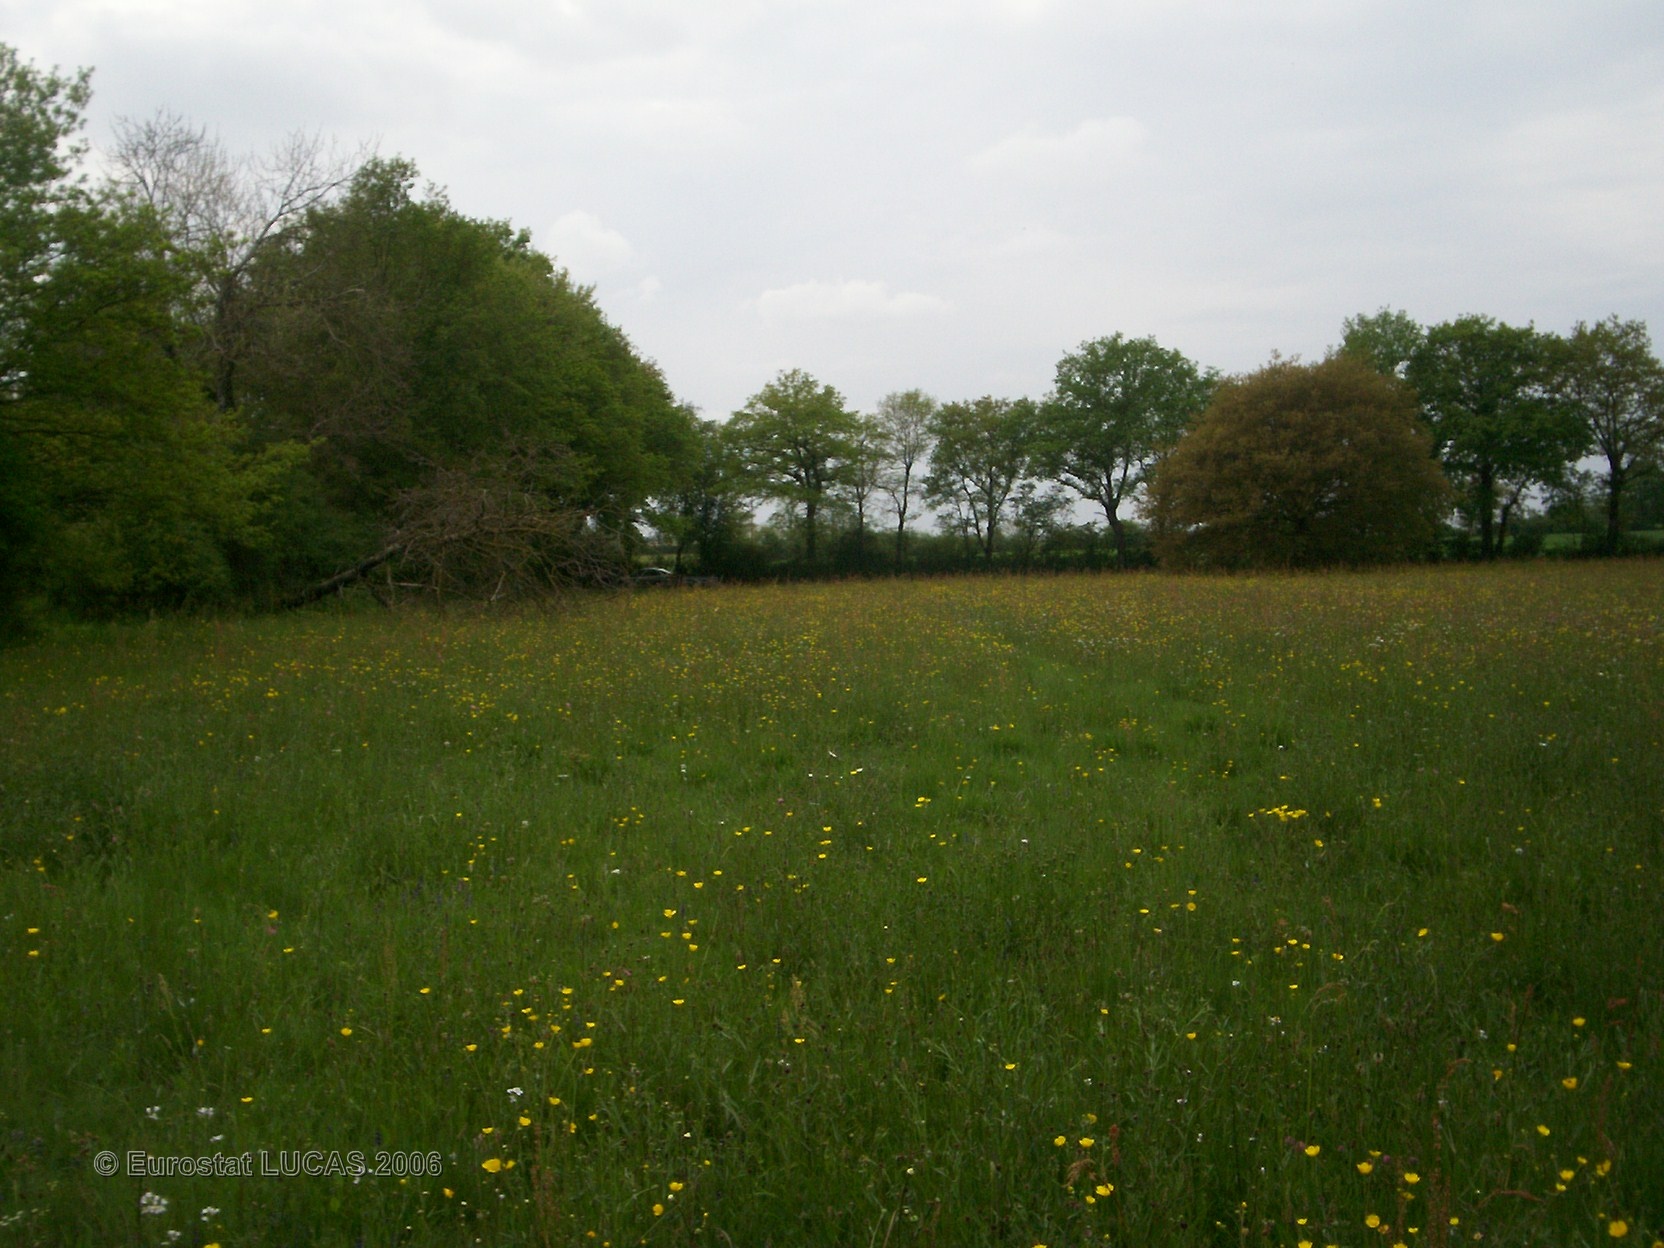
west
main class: Grassland
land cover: Grassland without tree/shrub cover
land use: Agriculture (excluding fallow land and kitchen gardens)
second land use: Amenities, museums, leisure
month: May
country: FR
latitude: 46.8555
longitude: -0.9852
